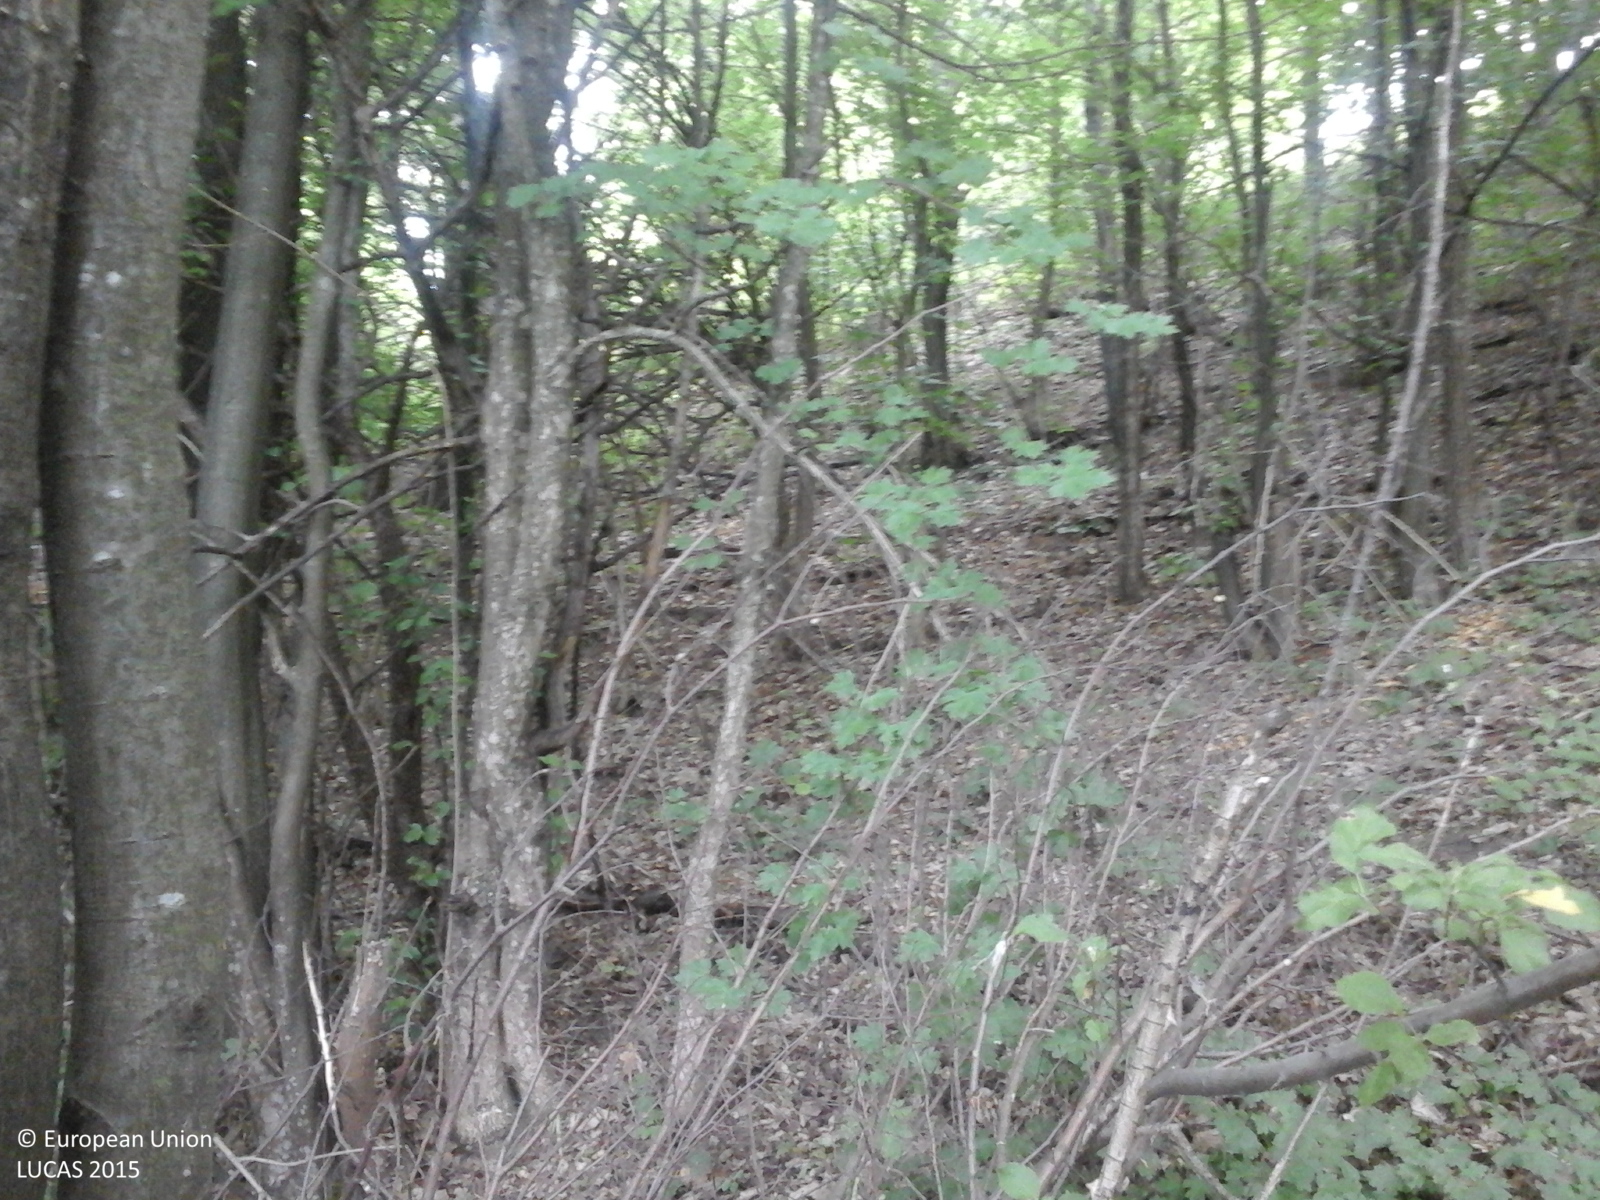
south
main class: Woodland
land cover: Broadleaved woodland
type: beech forest
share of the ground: > 75 %
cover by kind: broadleaved forest trees 100 %
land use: Forestry
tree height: > 5 m
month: June
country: RO
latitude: 46.5316
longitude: 26.7112
